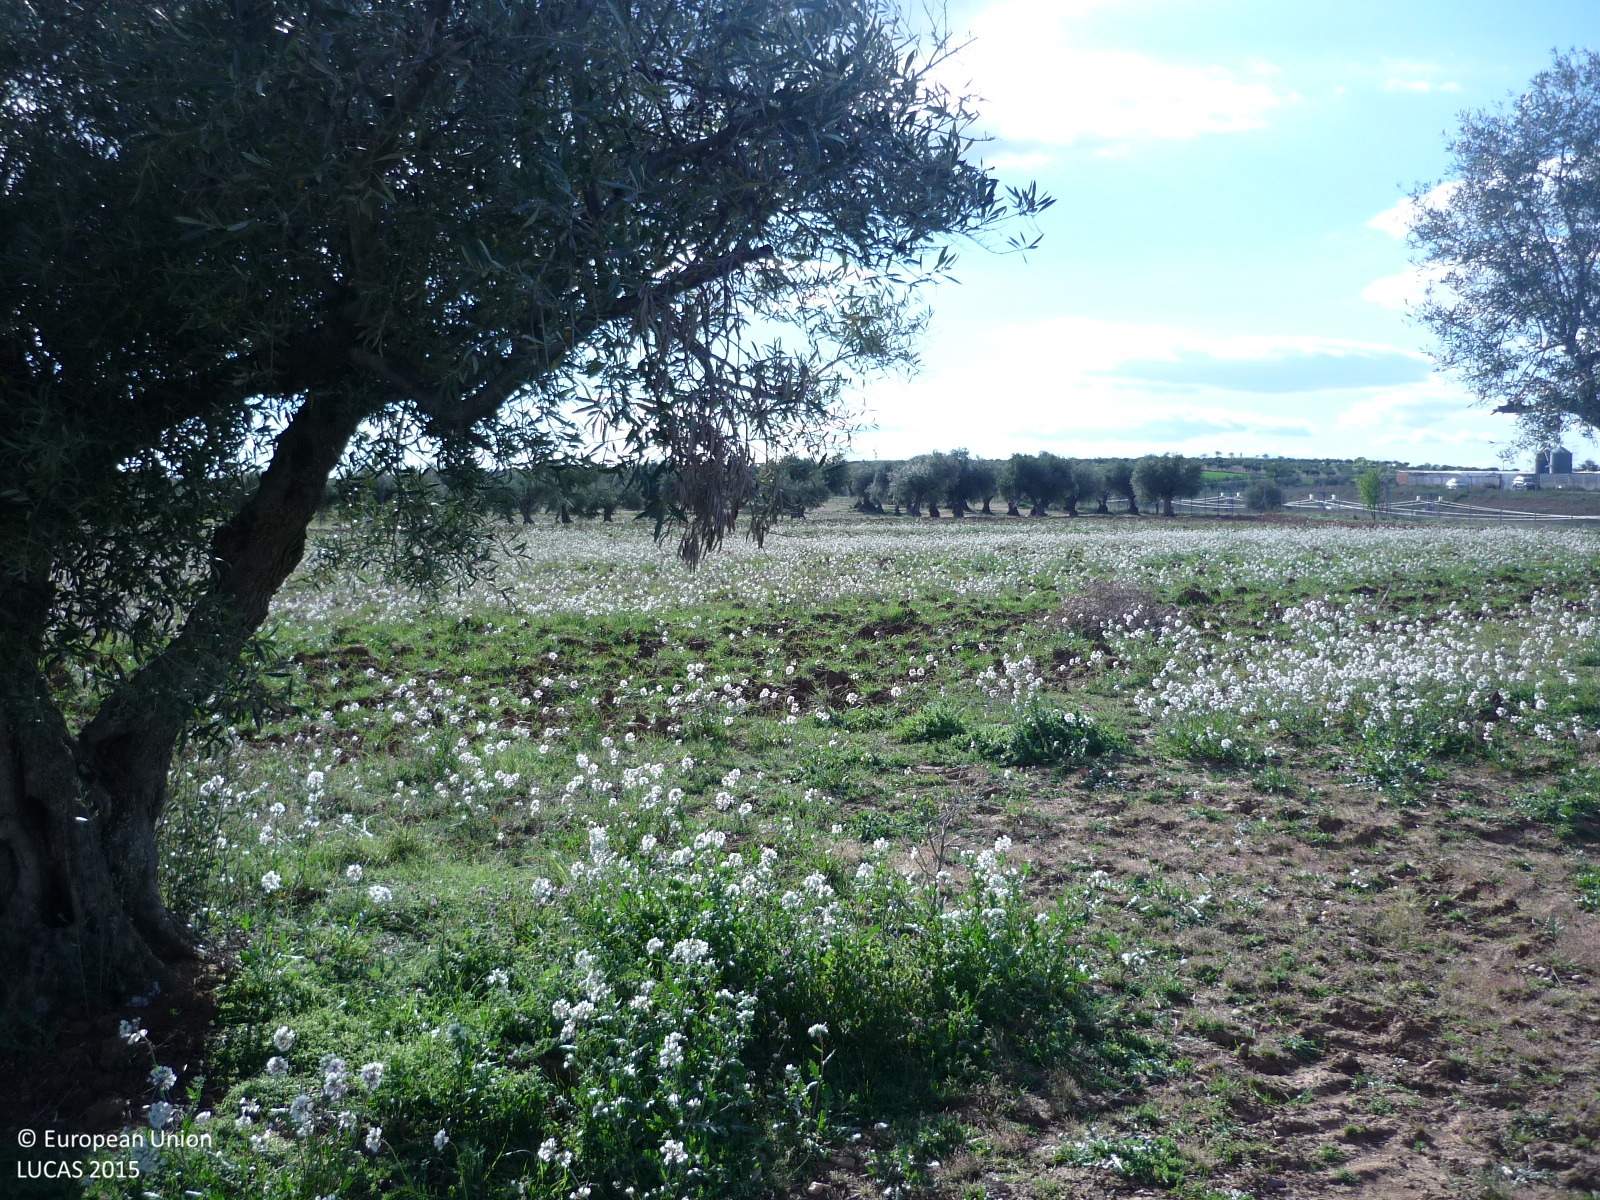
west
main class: Cropland
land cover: Olive groves
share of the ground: 50 - 75 %
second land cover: Grassland without tree/shrub cover
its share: > 75 %
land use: Agriculture (excluding fallow land and kitchen gardens)
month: March
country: ES
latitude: 40.4254
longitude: -3.3879
